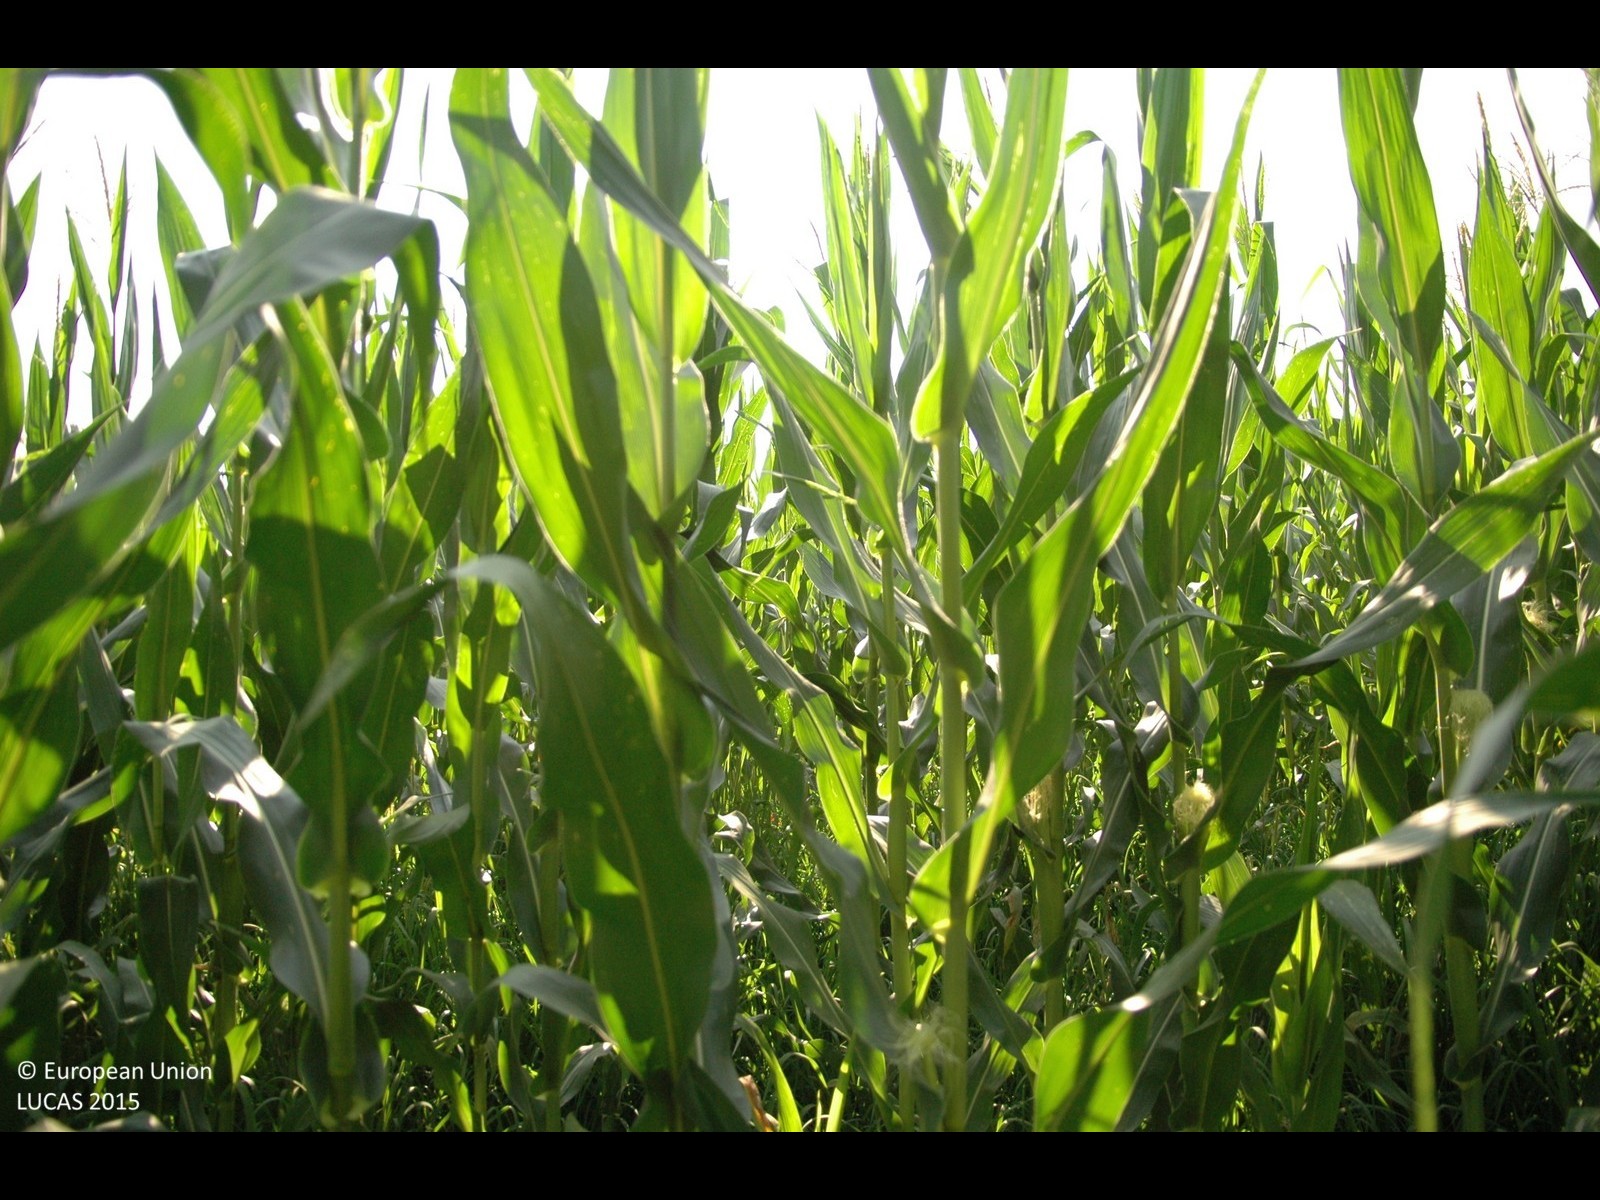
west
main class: Cropland
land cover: Maize
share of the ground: > 75 %
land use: Agriculture (excluding fallow land and kitchen gardens)
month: July
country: HR
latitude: 46.1838
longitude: 16.5948
